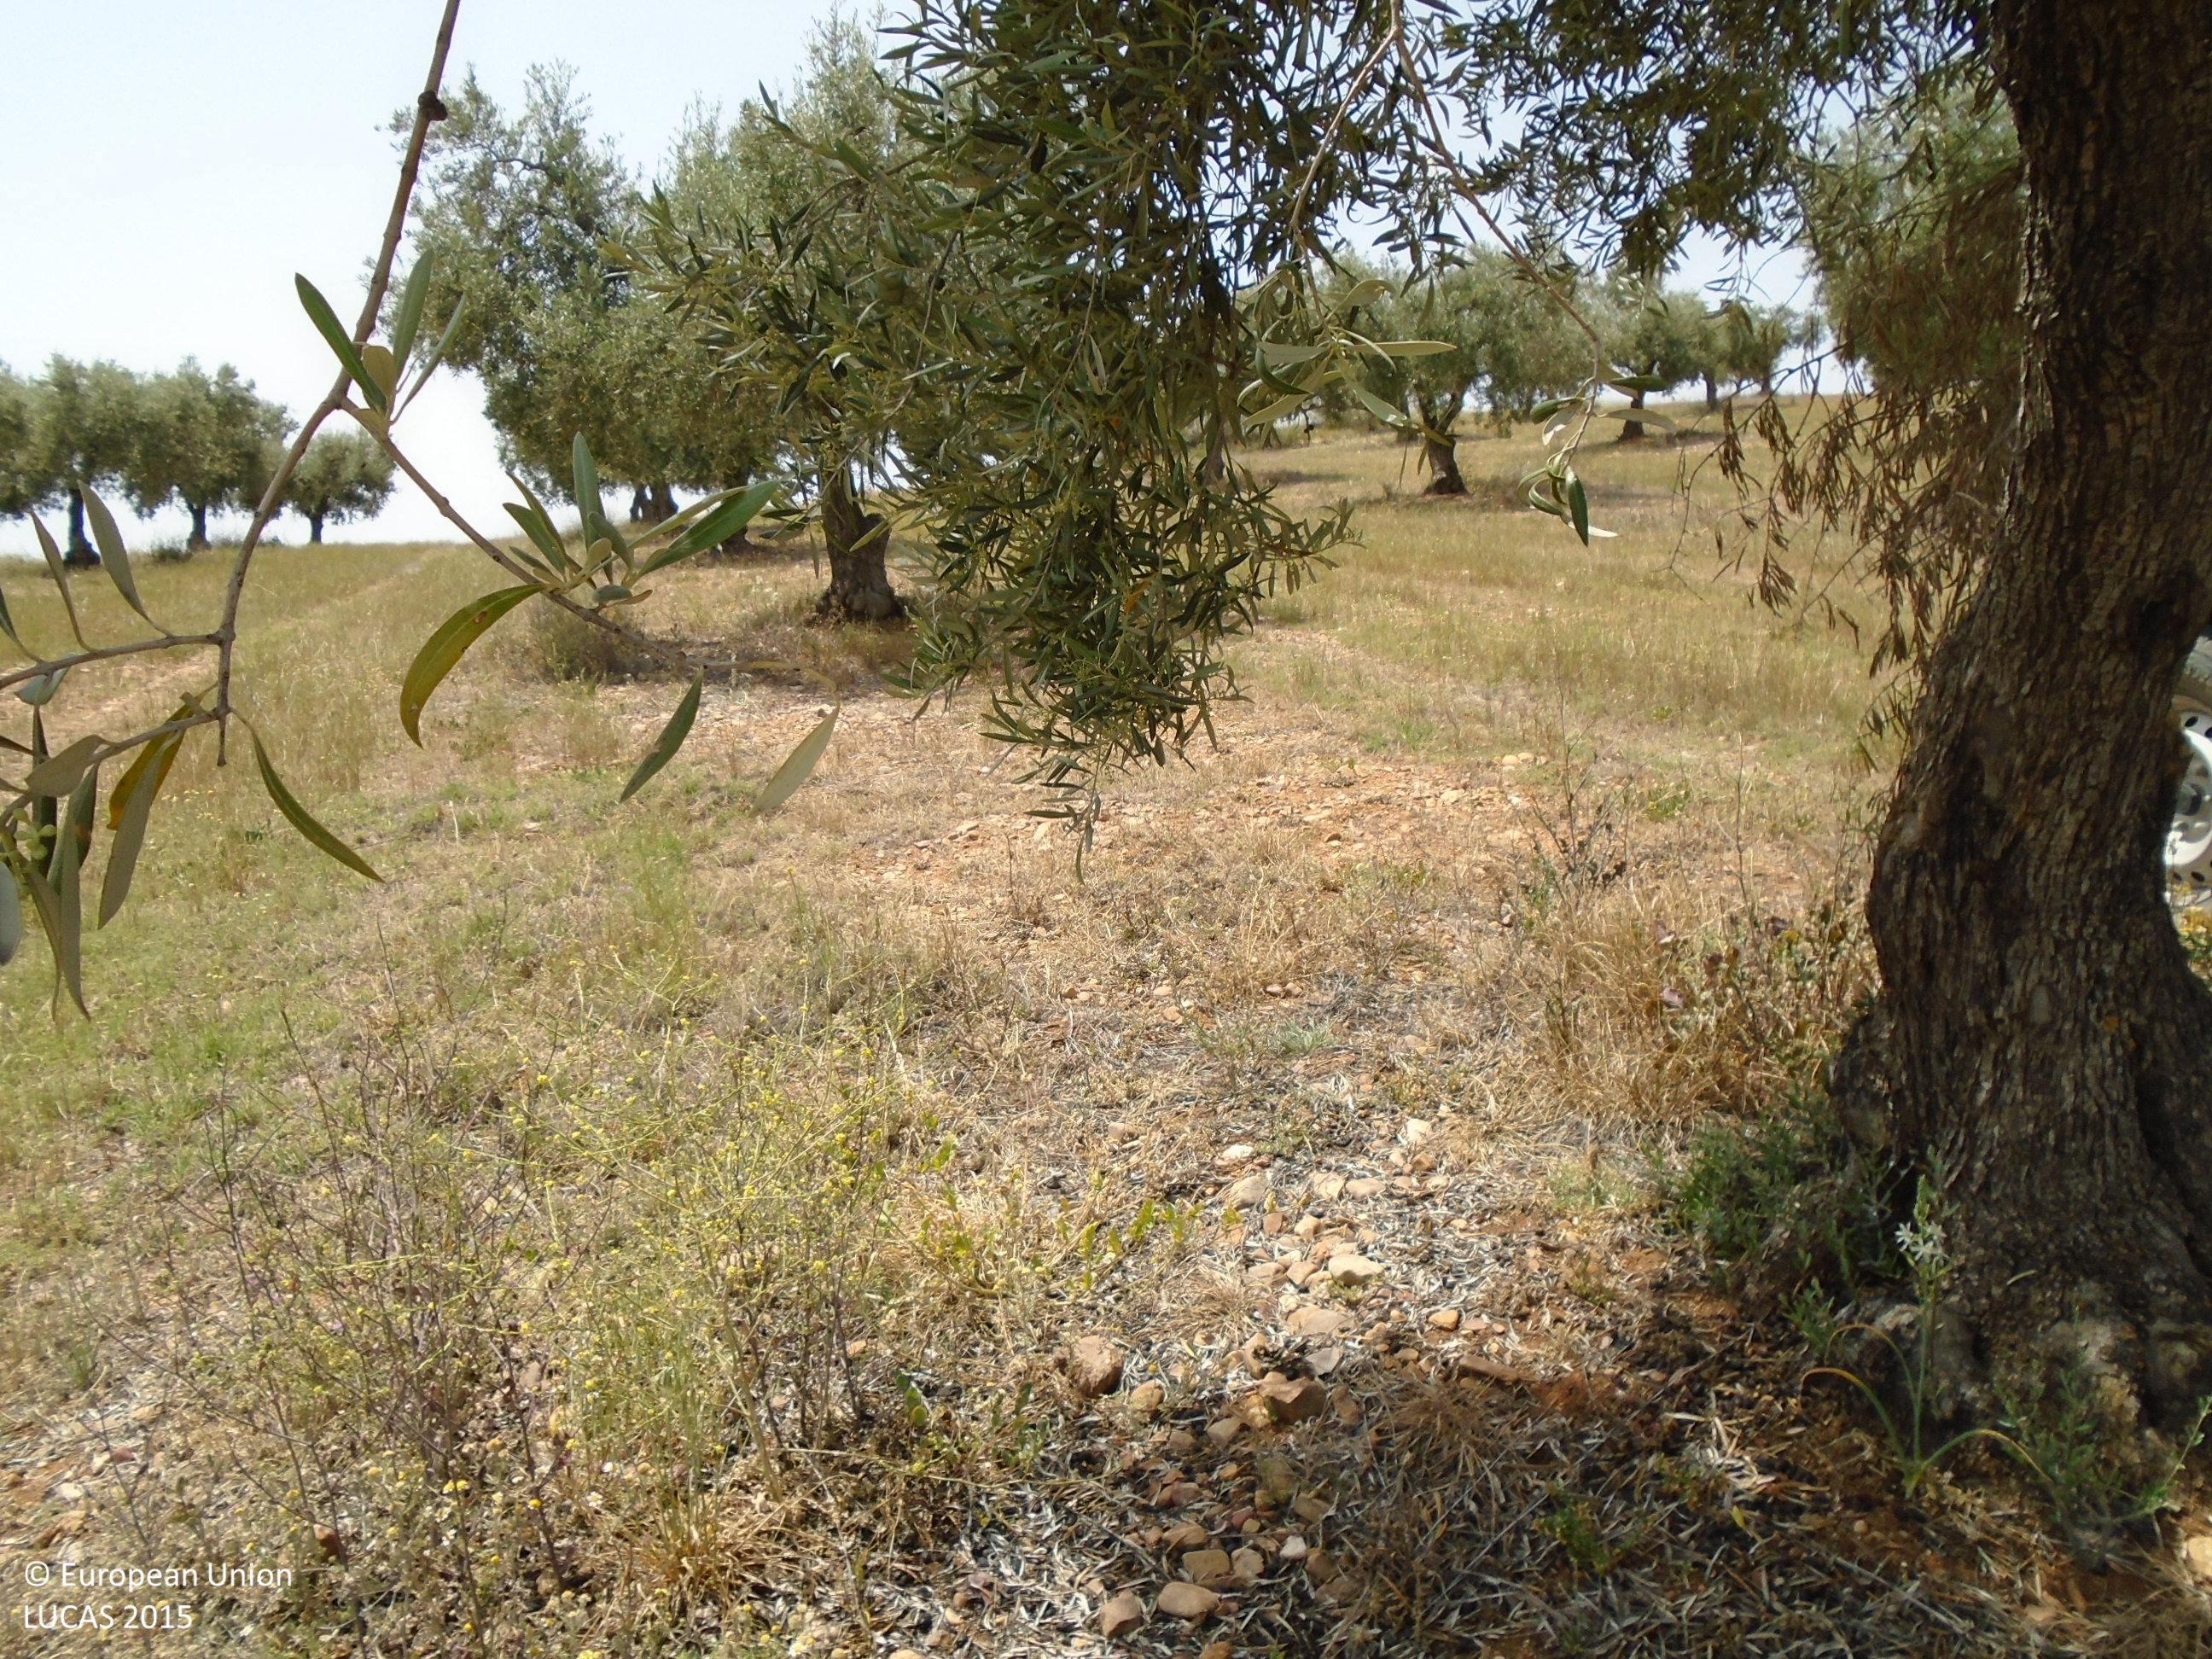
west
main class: Cropland
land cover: Olive groves
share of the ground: 10 - 25 %
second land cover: Spontaneously vegetated surfaces
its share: > 75 %
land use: Agriculture (excluding fallow land and kitchen gardens)
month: May
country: ES
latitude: 39.7496
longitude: -4.6418
